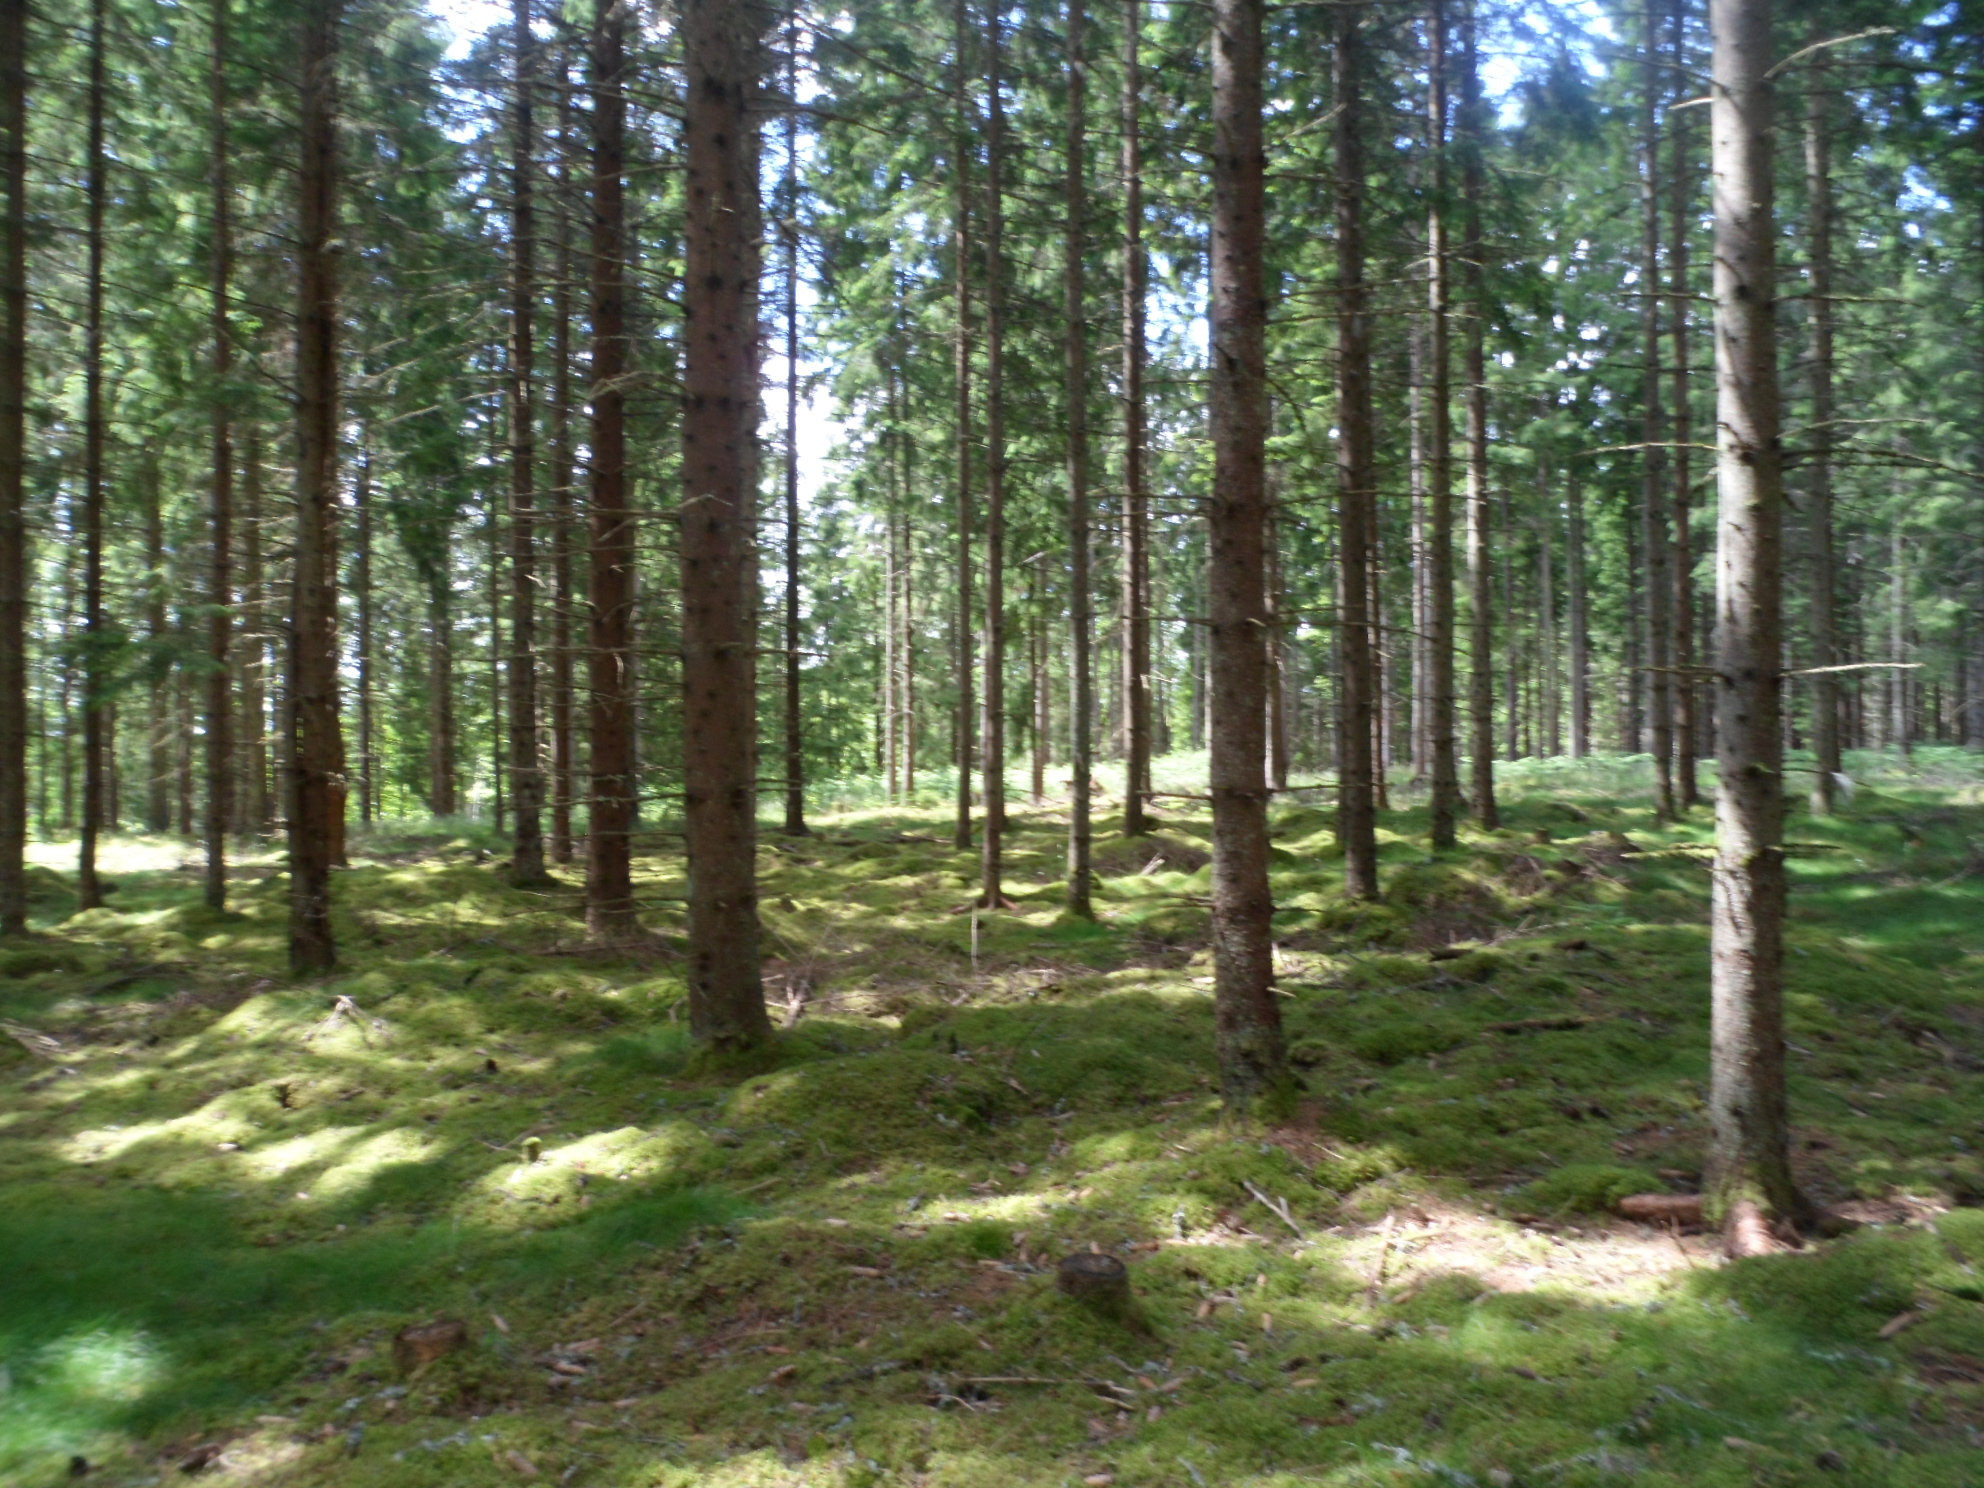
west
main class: Woodland
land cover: Spruce dominated coniferous woodland
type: boreal forest
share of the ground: 50 - 75 %
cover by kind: coniferous forest trees 65 %, lichens and mosses 20 %, shrubs 10 %, unconsolidated bare surface 5 %
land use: Forestry
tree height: > 5 m
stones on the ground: < 10 %
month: June
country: SE
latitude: 57.1080
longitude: 14.7682
